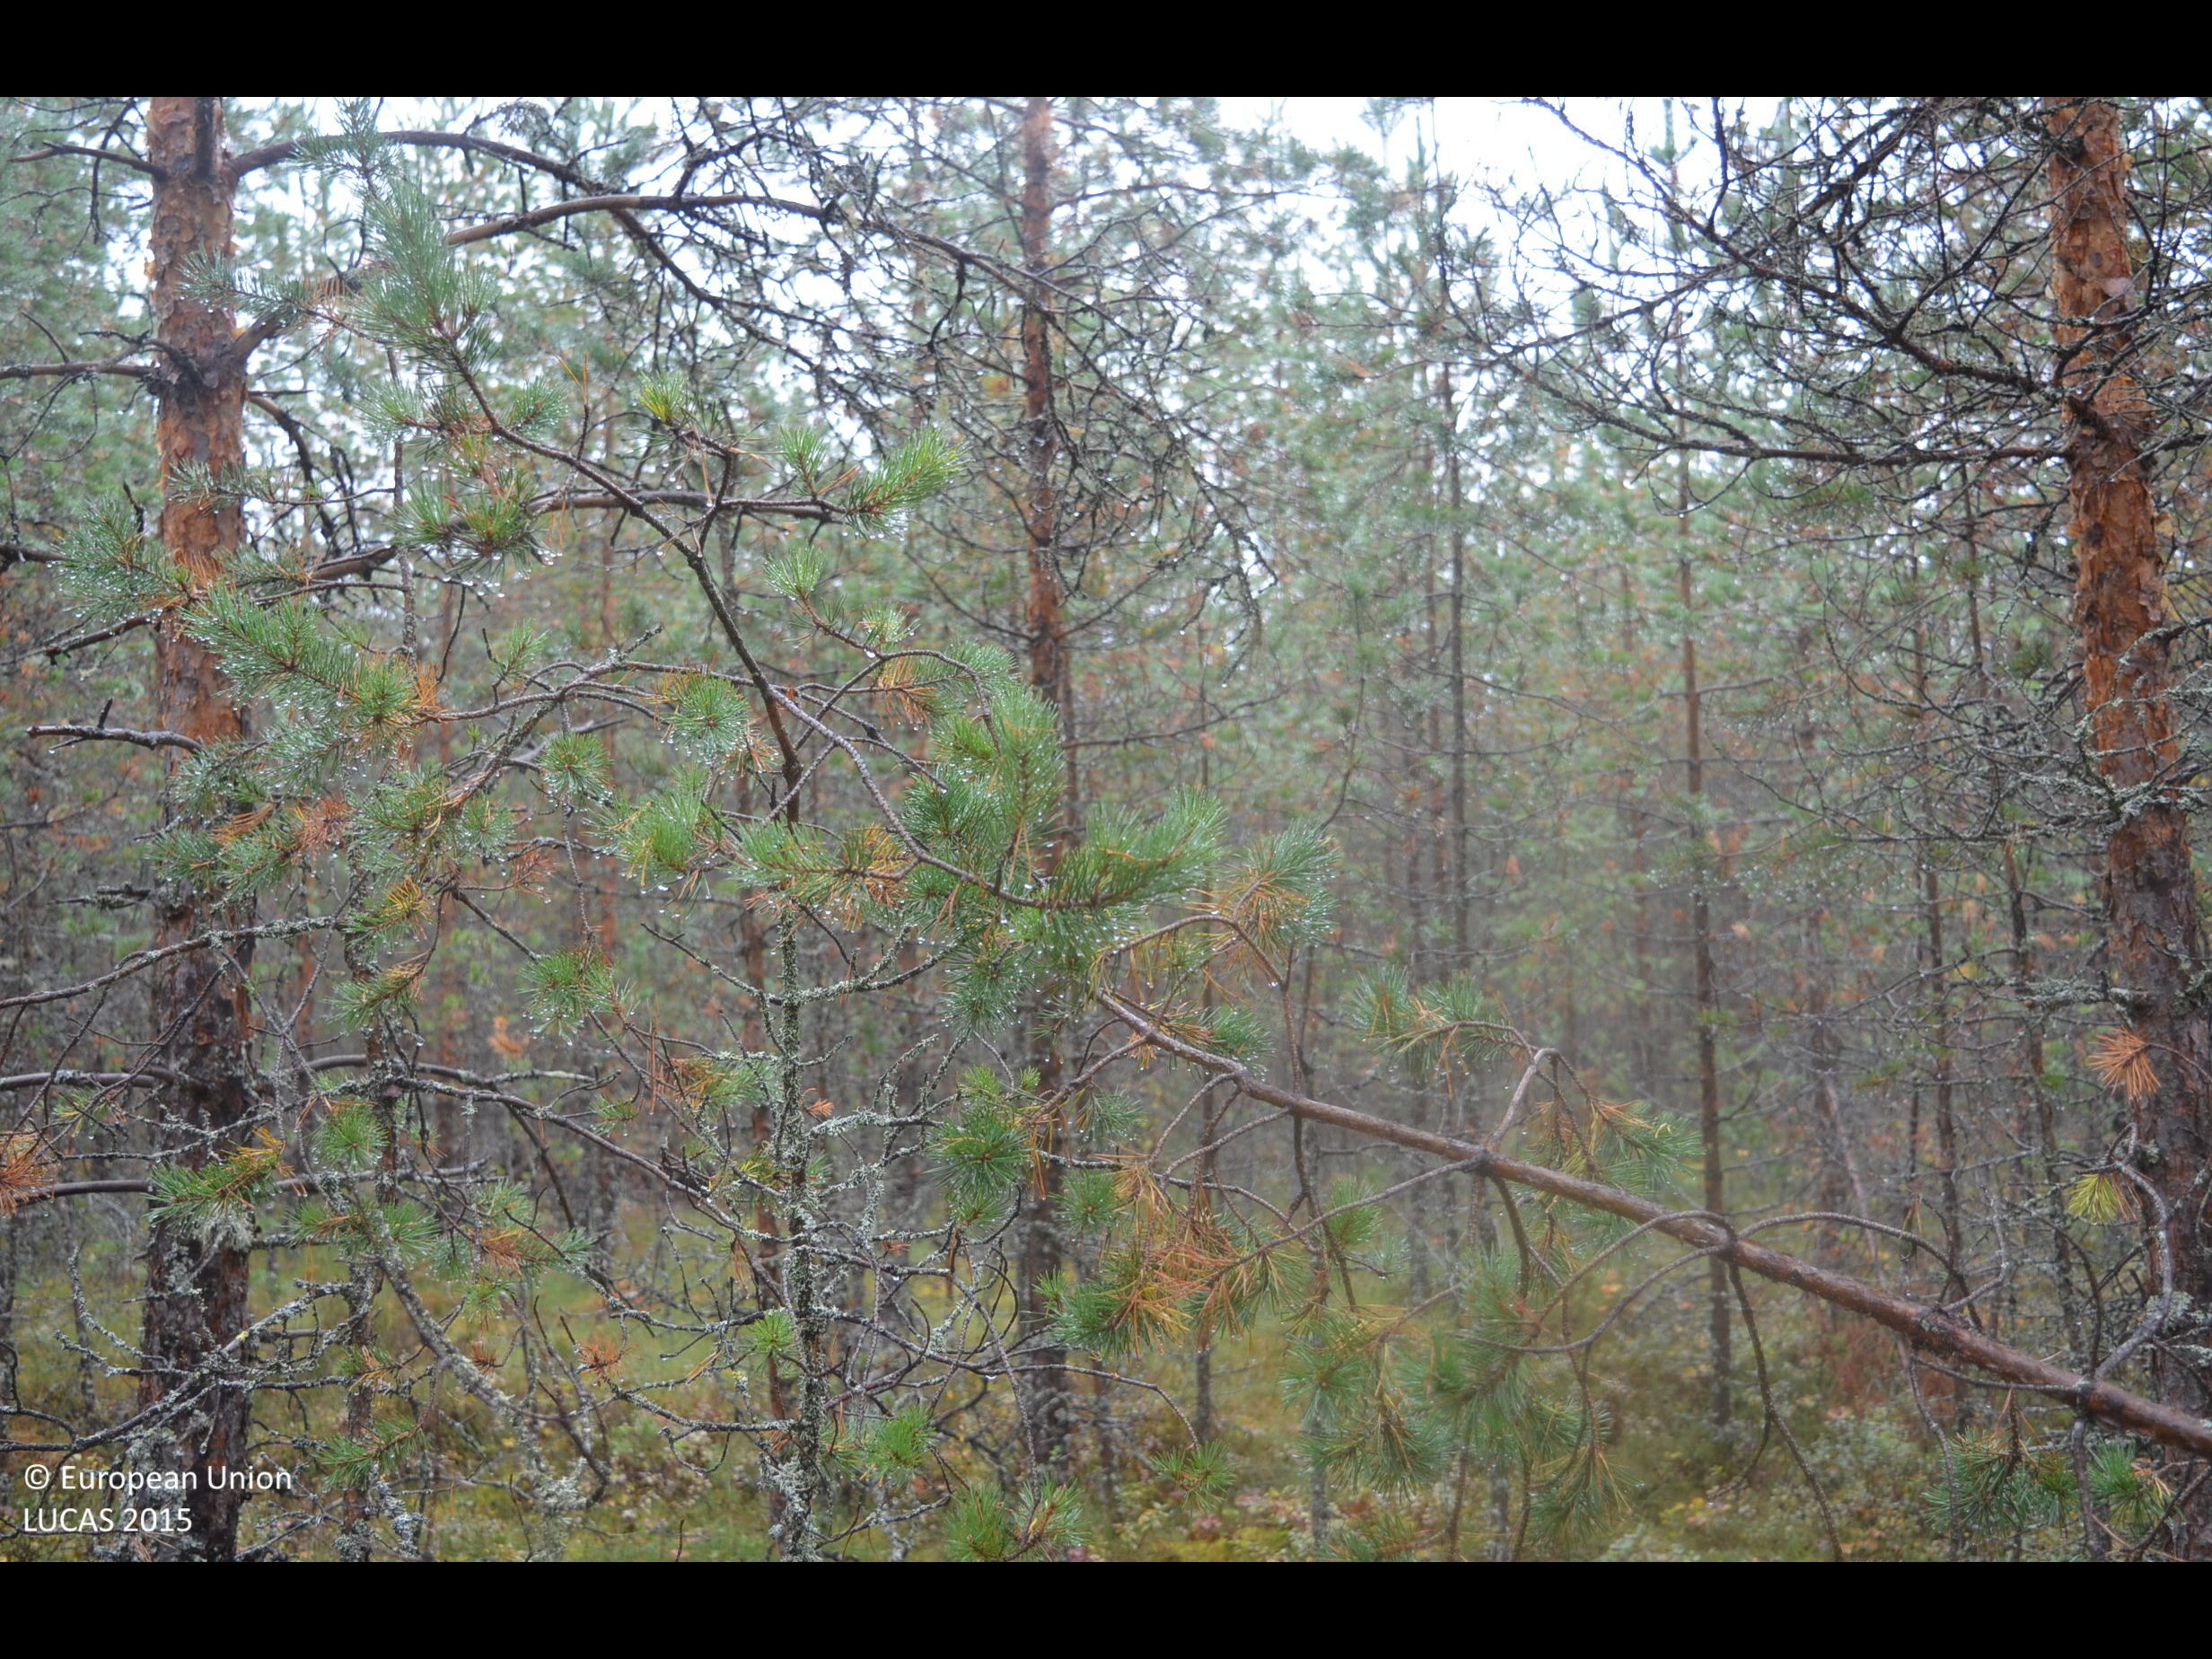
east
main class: Woodland
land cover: Pine dominated coniferous woodland
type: boreal forest
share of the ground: > 75 %
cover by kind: coniferous forest trees 70 %, shrubs 10 %, lichens and mosses 10 %, broadleaved forest trees 5 %, herbaceous plants 5 %
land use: Forestry
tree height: < 5 m
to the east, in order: Pine dominated coniferous woodland; Ditches and canals; Pine dominated coniferous woodland; Ditches and canals; Pine dominated coniferous woodland; Ditches and canals; Pine dominated mixed woodland; Ditches and canals; Pine dominated mixed woodland
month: September
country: FI
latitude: 62.9487
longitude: 23.9702
